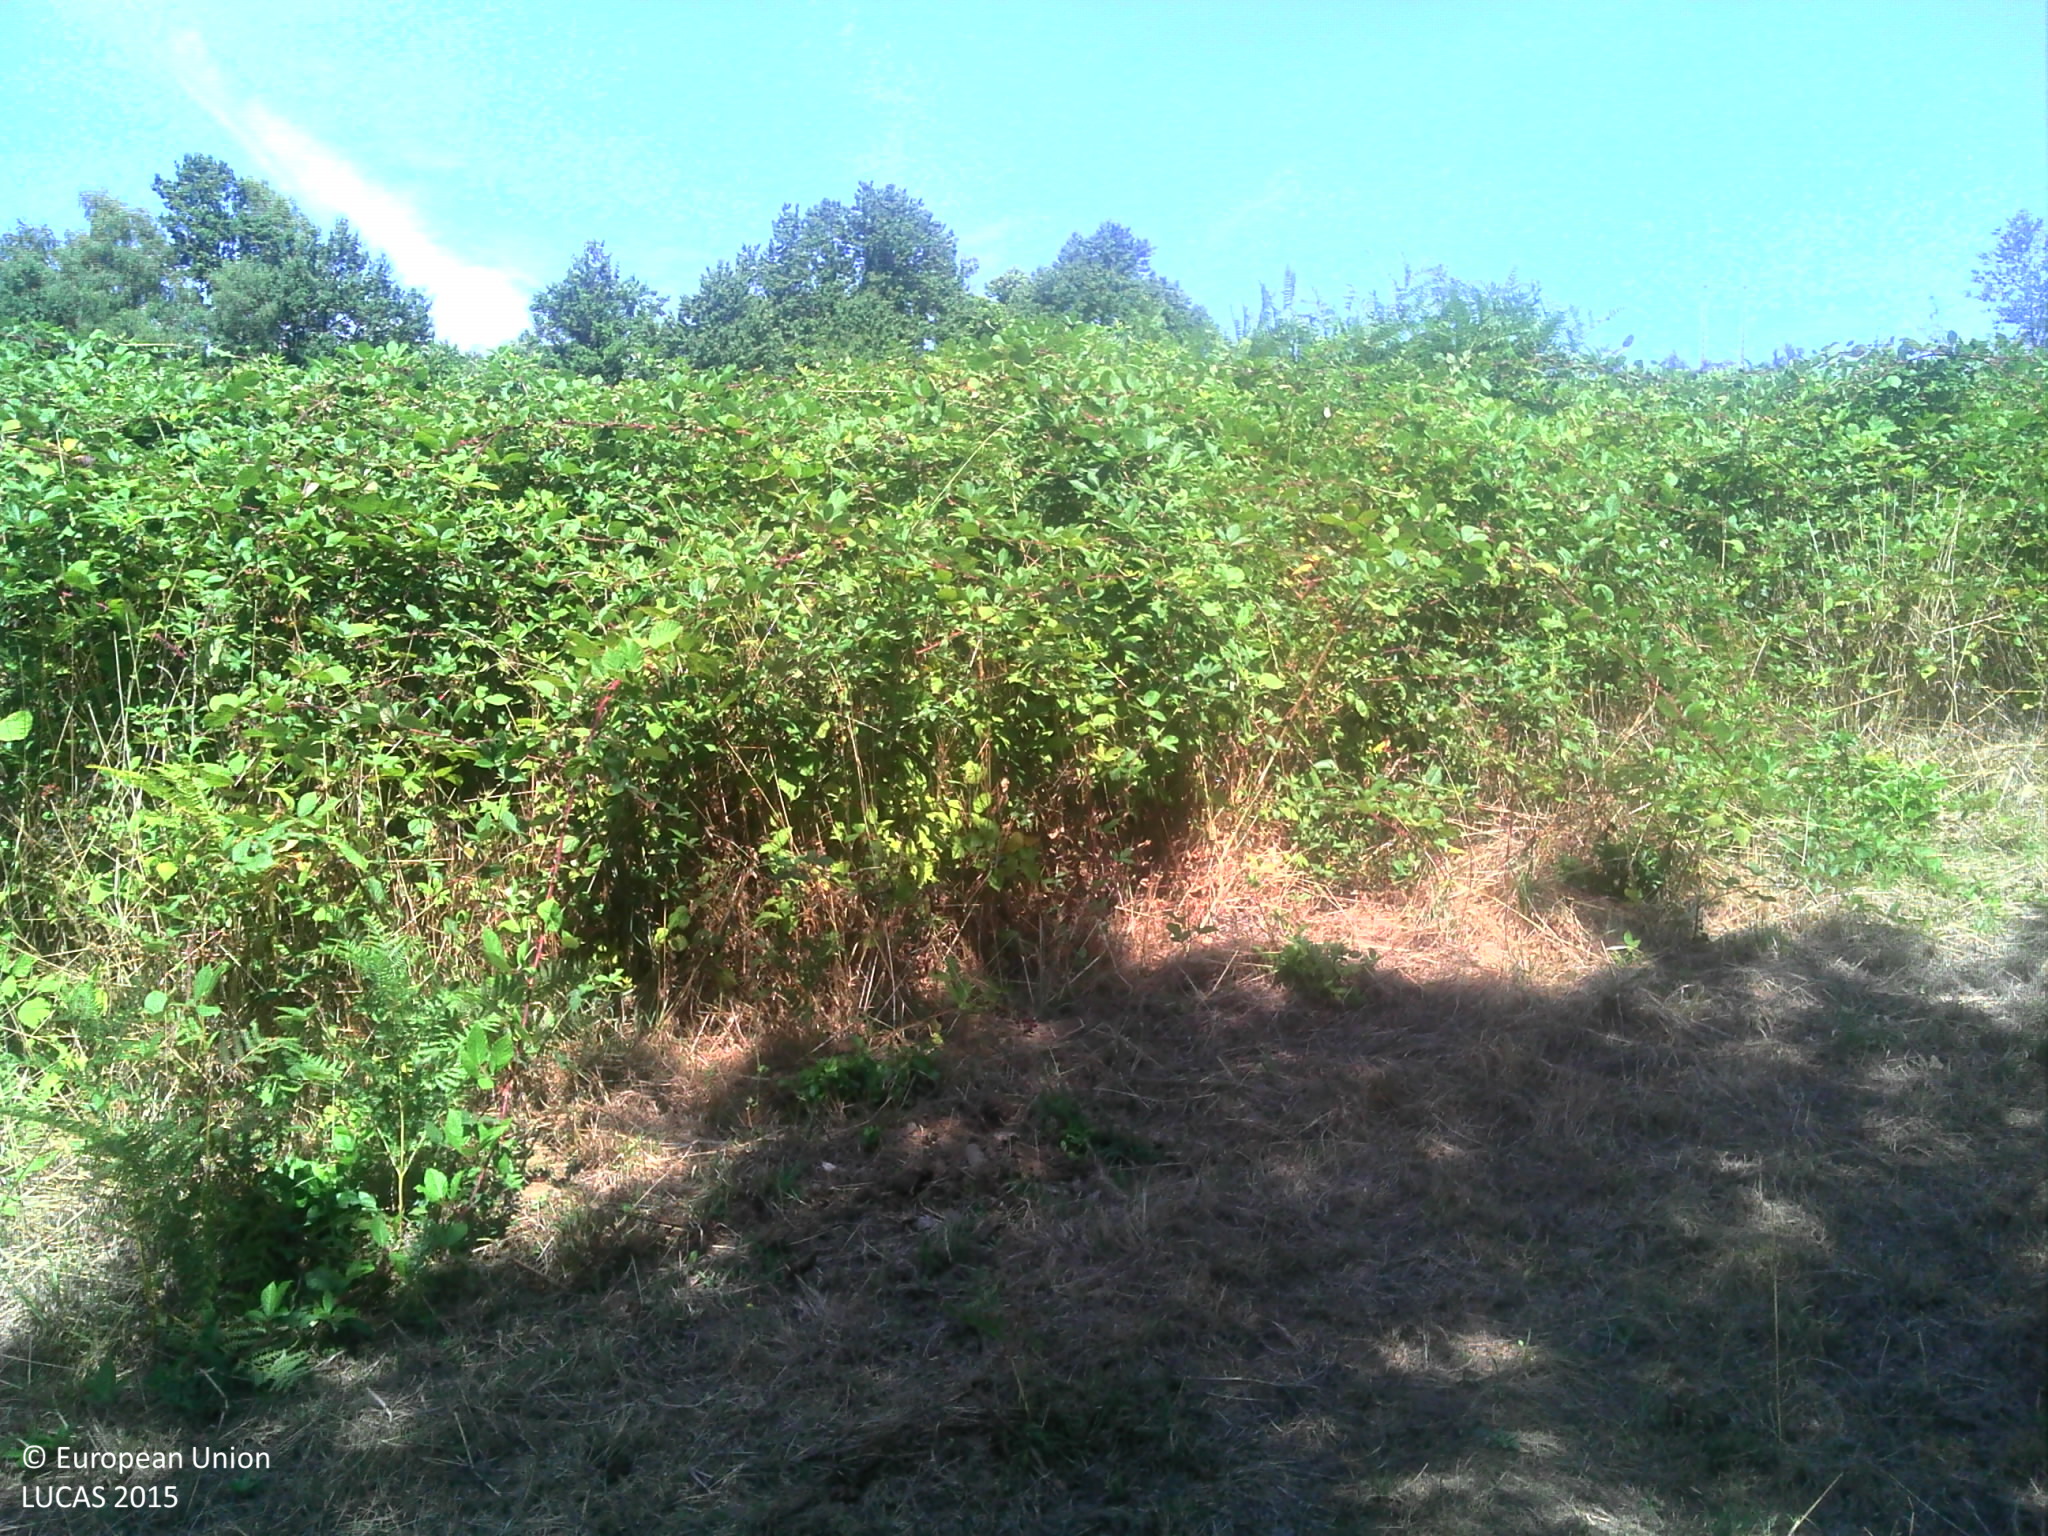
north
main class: Grassland
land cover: Grassland without tree/shrub cover
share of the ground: > 75 %
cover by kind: herbaceous plants 95 %, shrubs 5 %
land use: Agriculture (excluding fallow land and kitchen gardens)
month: August
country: FR
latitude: 45.3168
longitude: 1.4089
